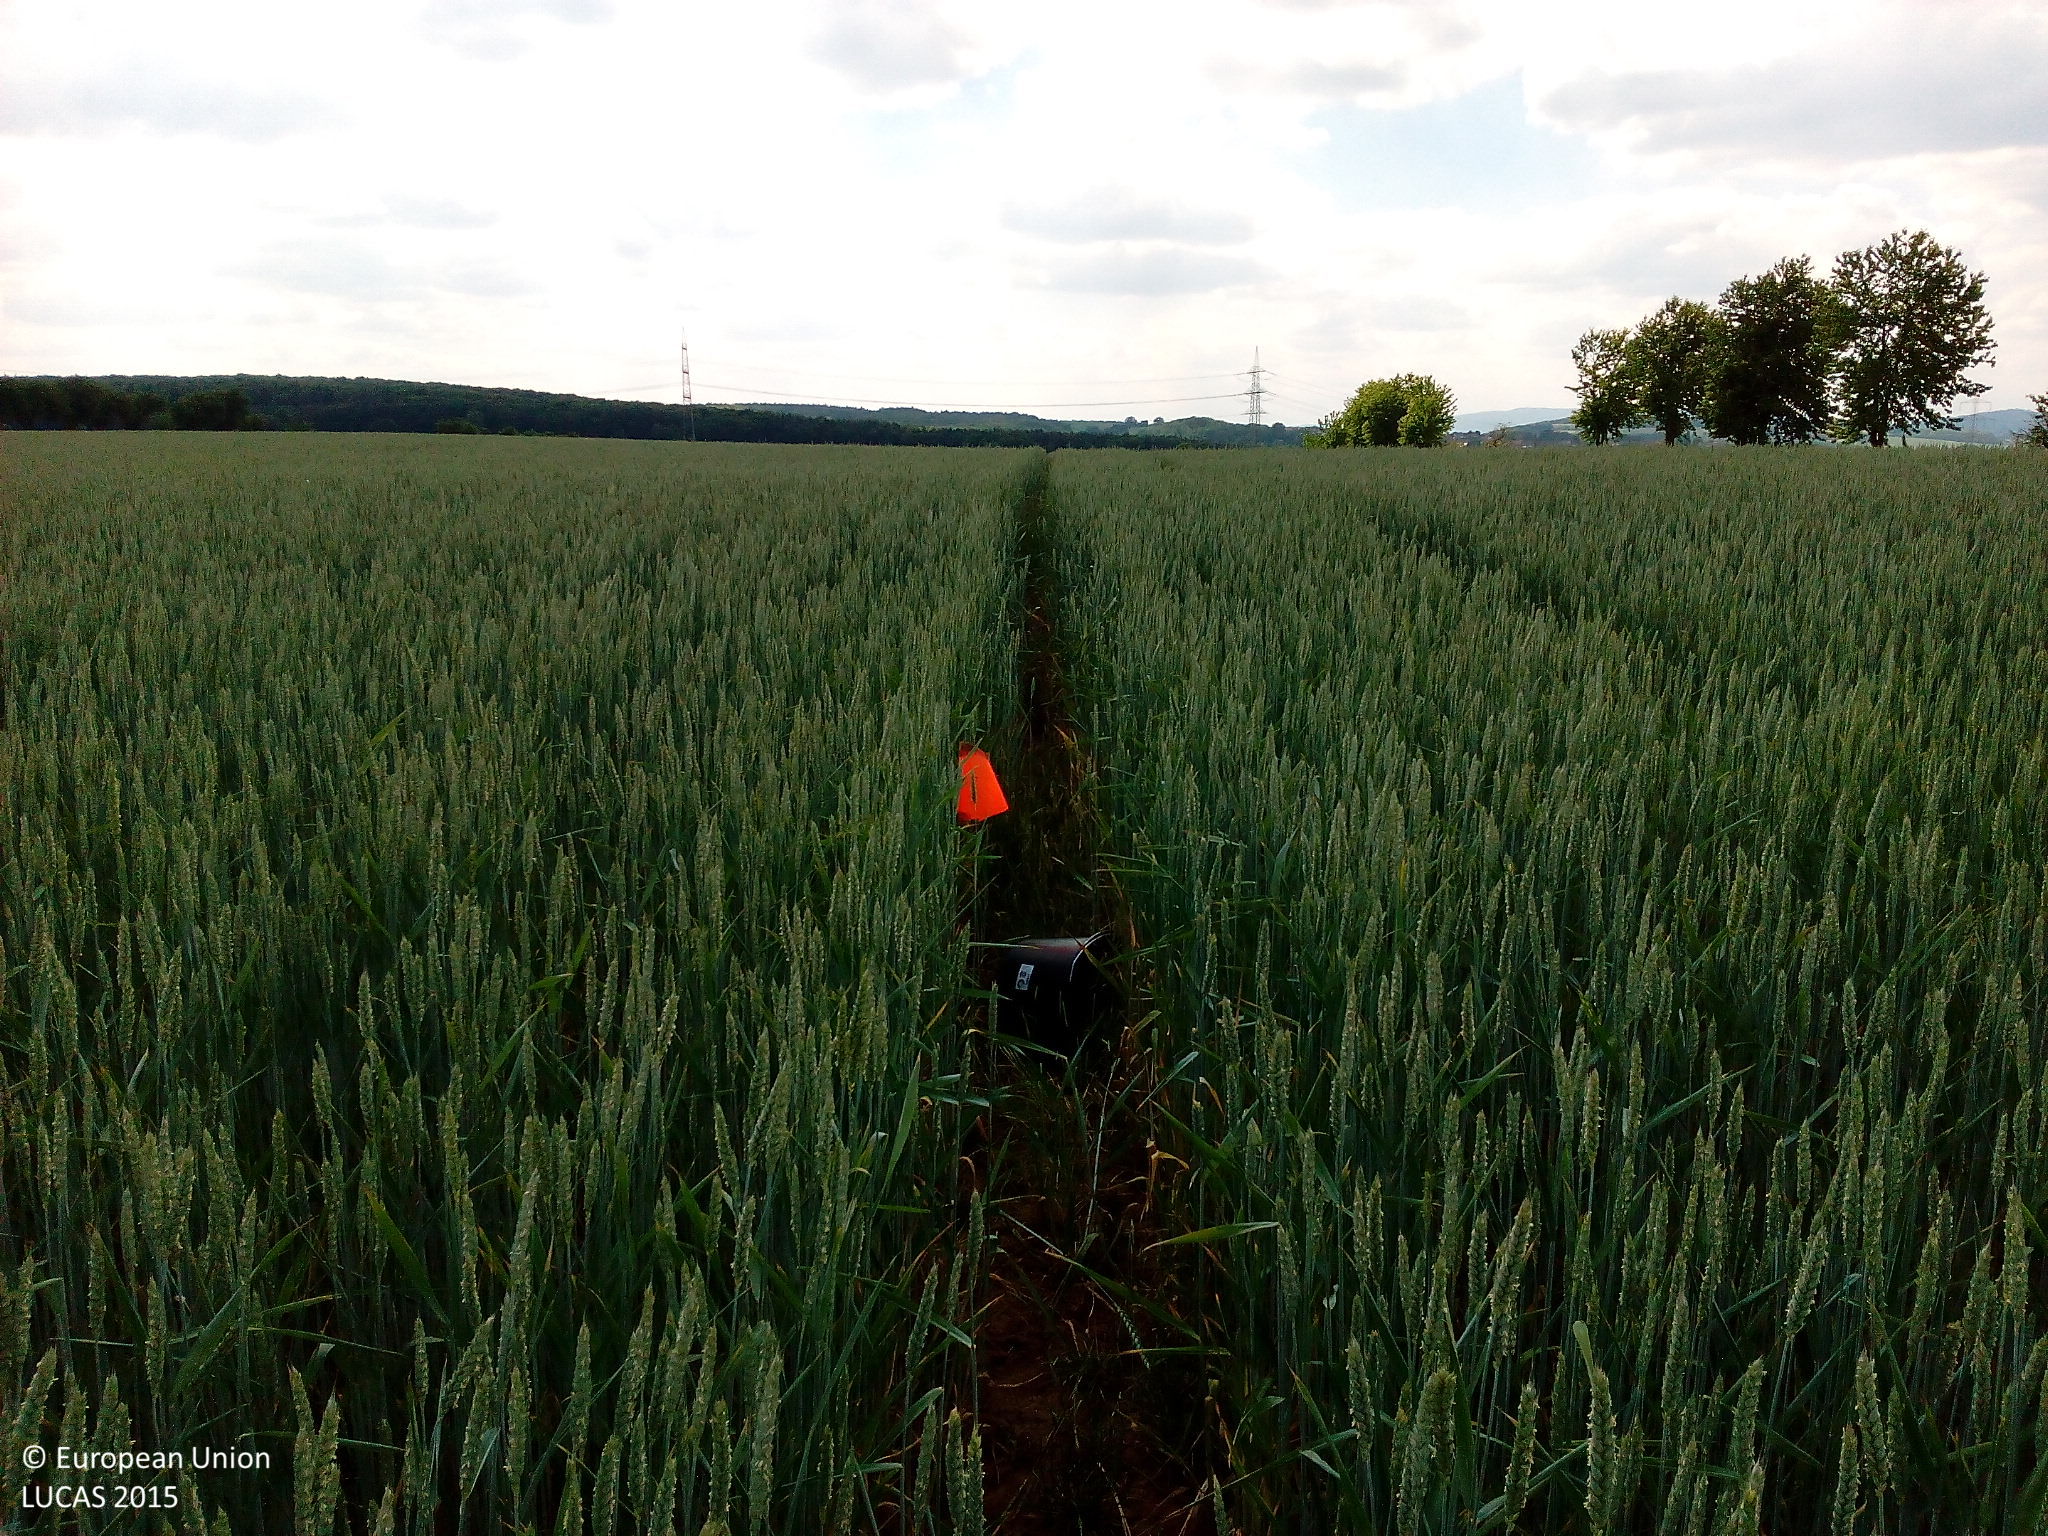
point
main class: Cropland
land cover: Common wheat
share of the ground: > 75 %
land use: Agriculture (excluding fallow land and kitchen gardens)
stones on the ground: < 10 %
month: June
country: DE
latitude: 51.0275
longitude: 9.3586
